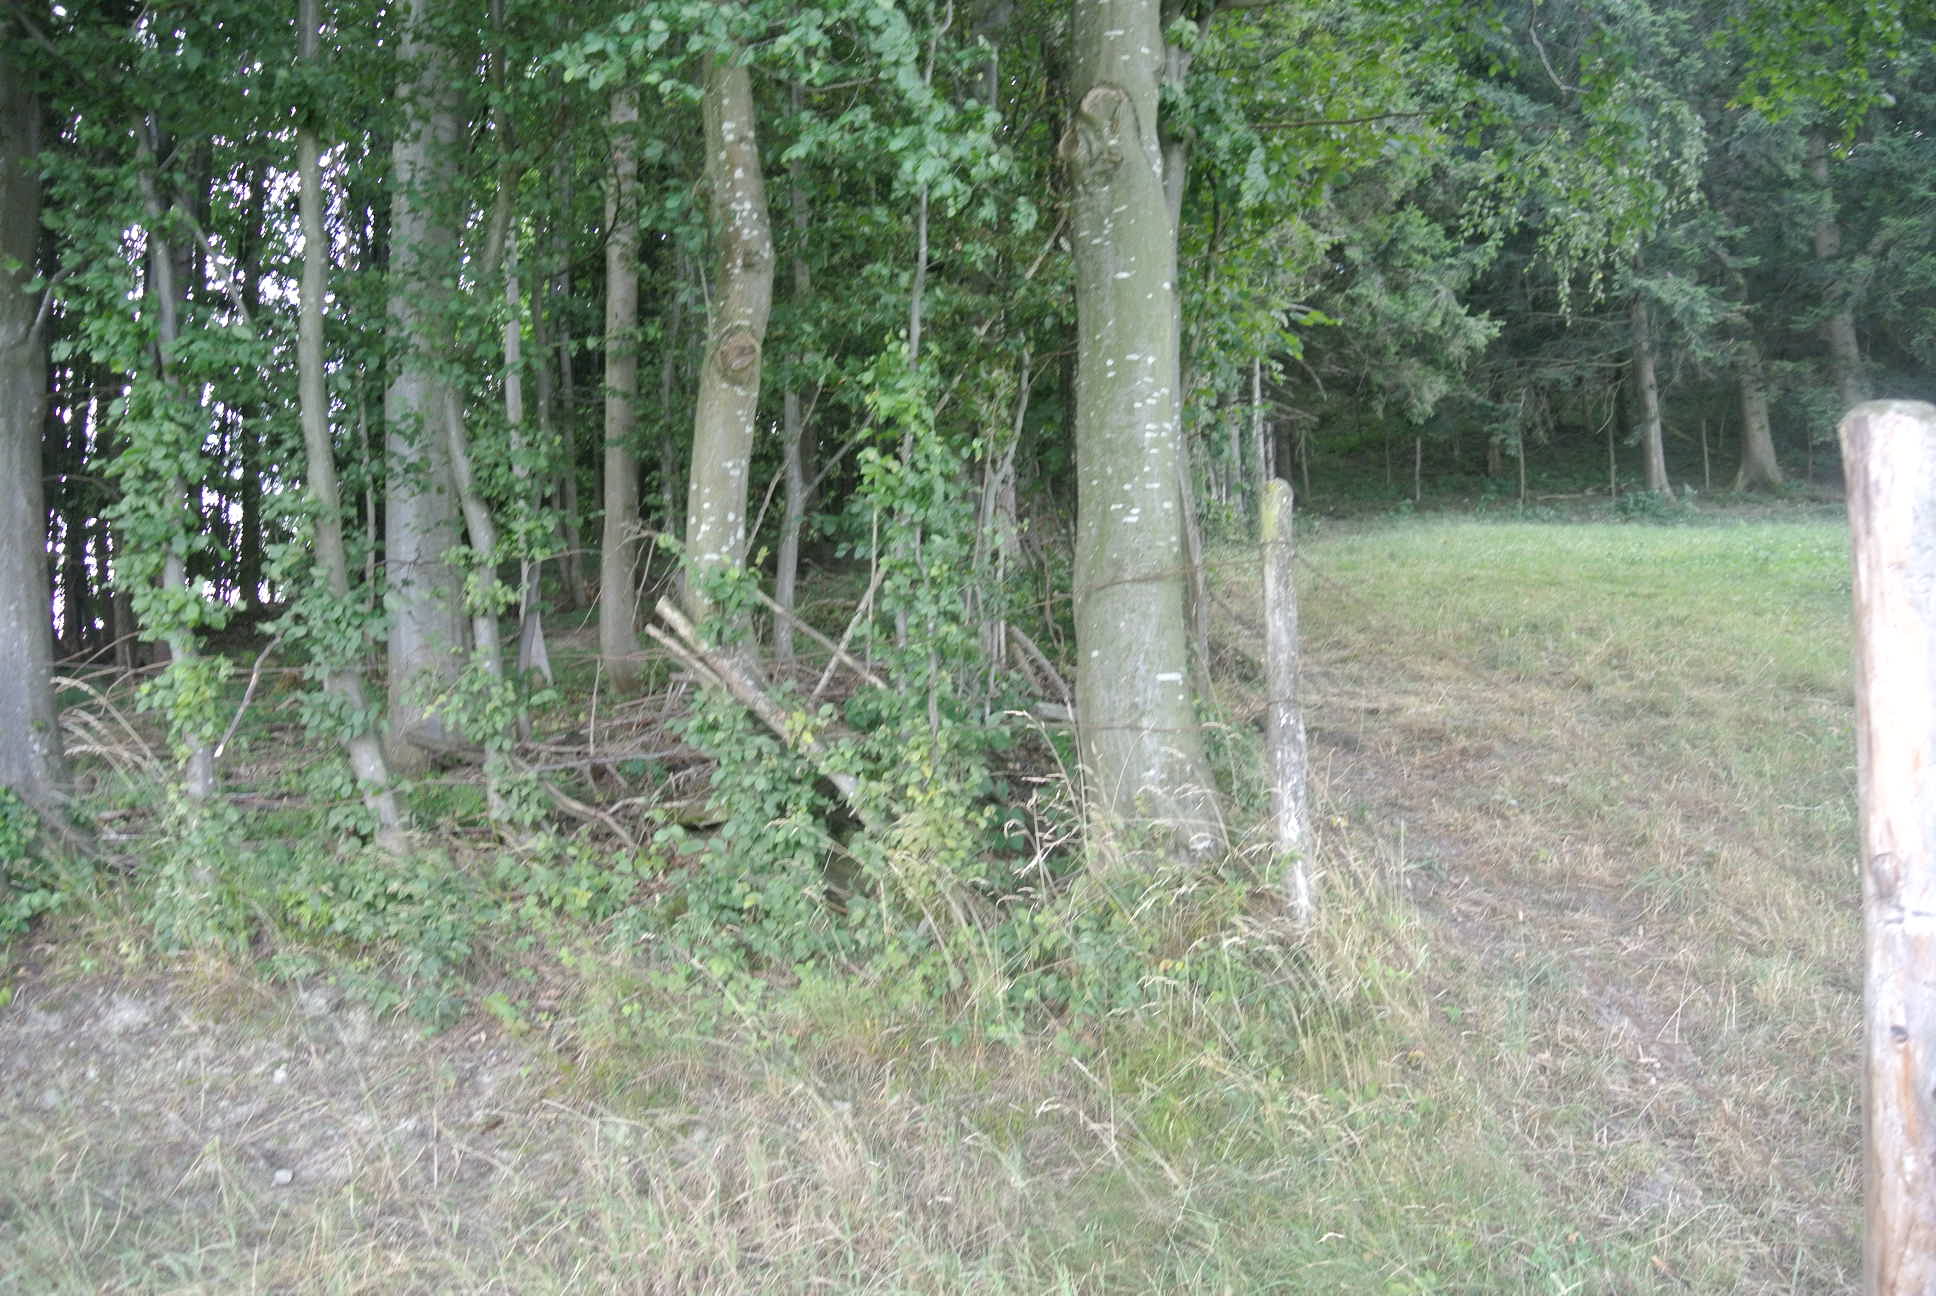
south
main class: Grassland
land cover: Grassland without tree/shrub cover
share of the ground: > 75 %
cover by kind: herbaceous plants 100 %
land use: Agriculture (excluding fallow land and kitchen gardens)
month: July
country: AT
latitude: 48.0175
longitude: 15.4317
